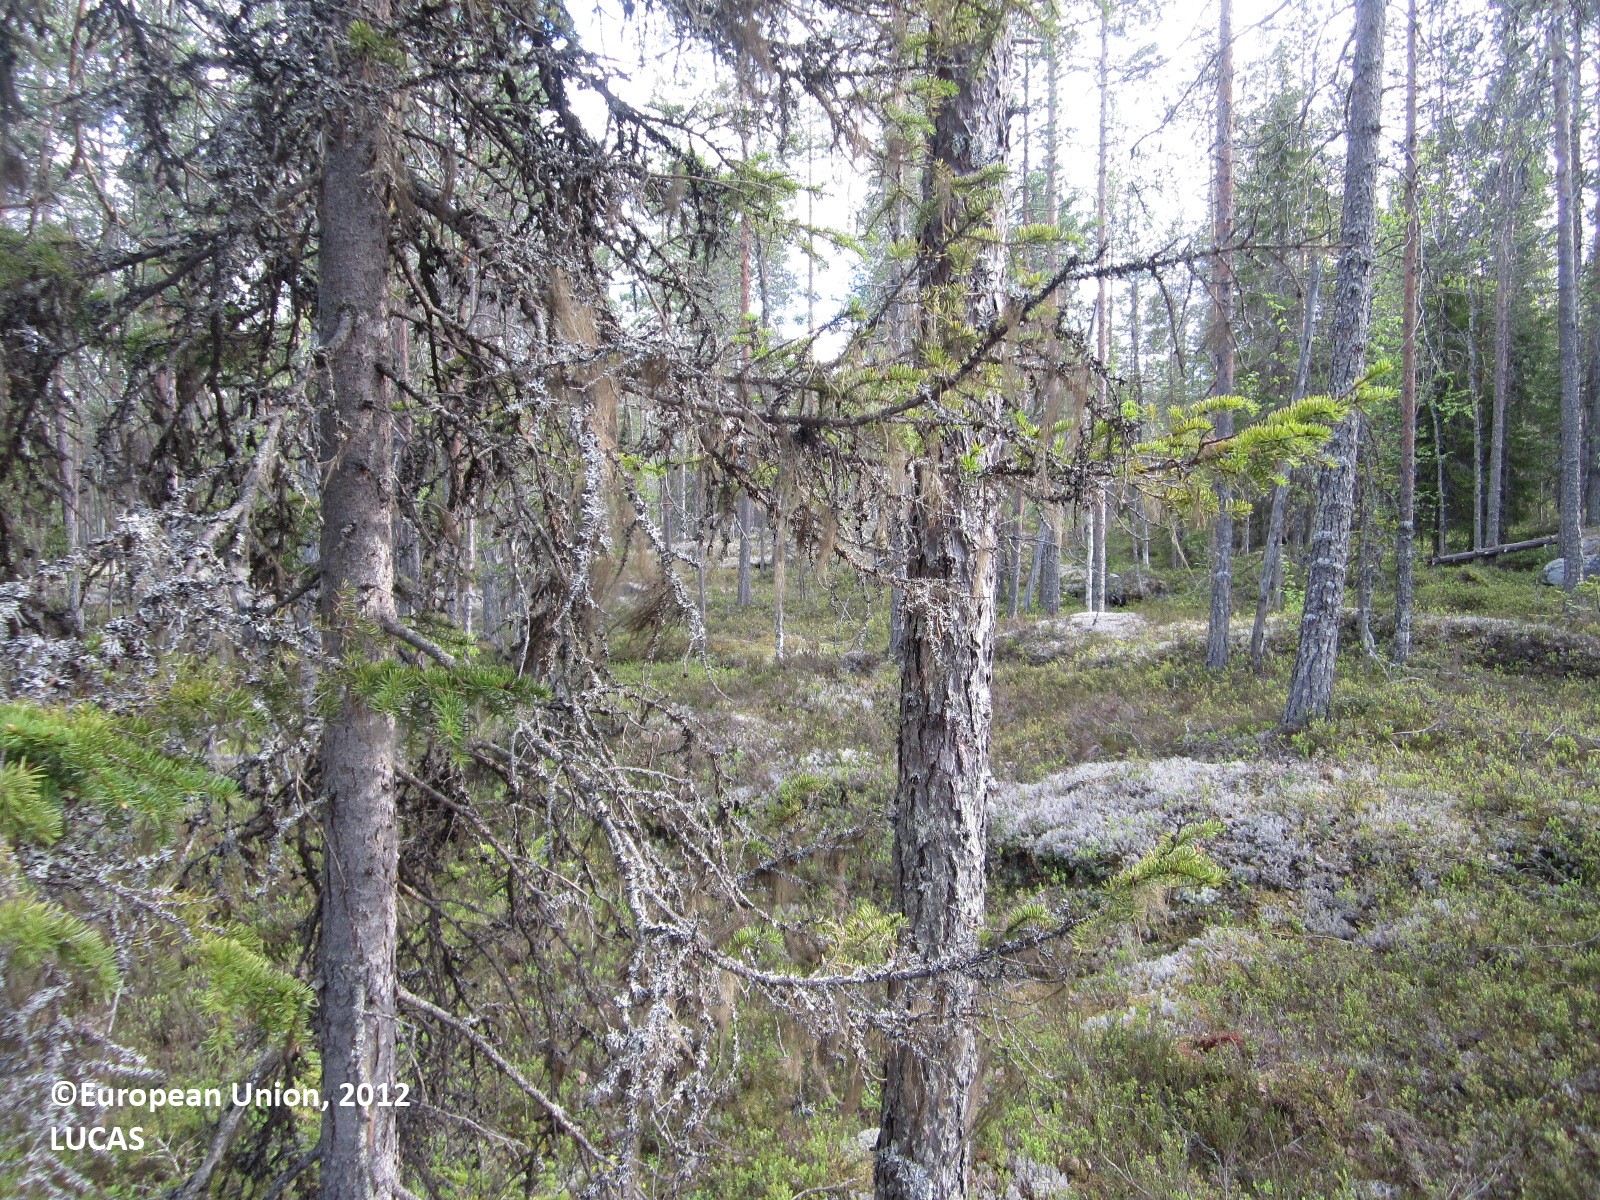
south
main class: Woodland
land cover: Other coniferous woodland
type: boreal forest
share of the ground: 50 - 75 %
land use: Semi-natural and natural areas not in use
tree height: > 5 m
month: June
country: FI
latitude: 64.5921
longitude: 28.5807
